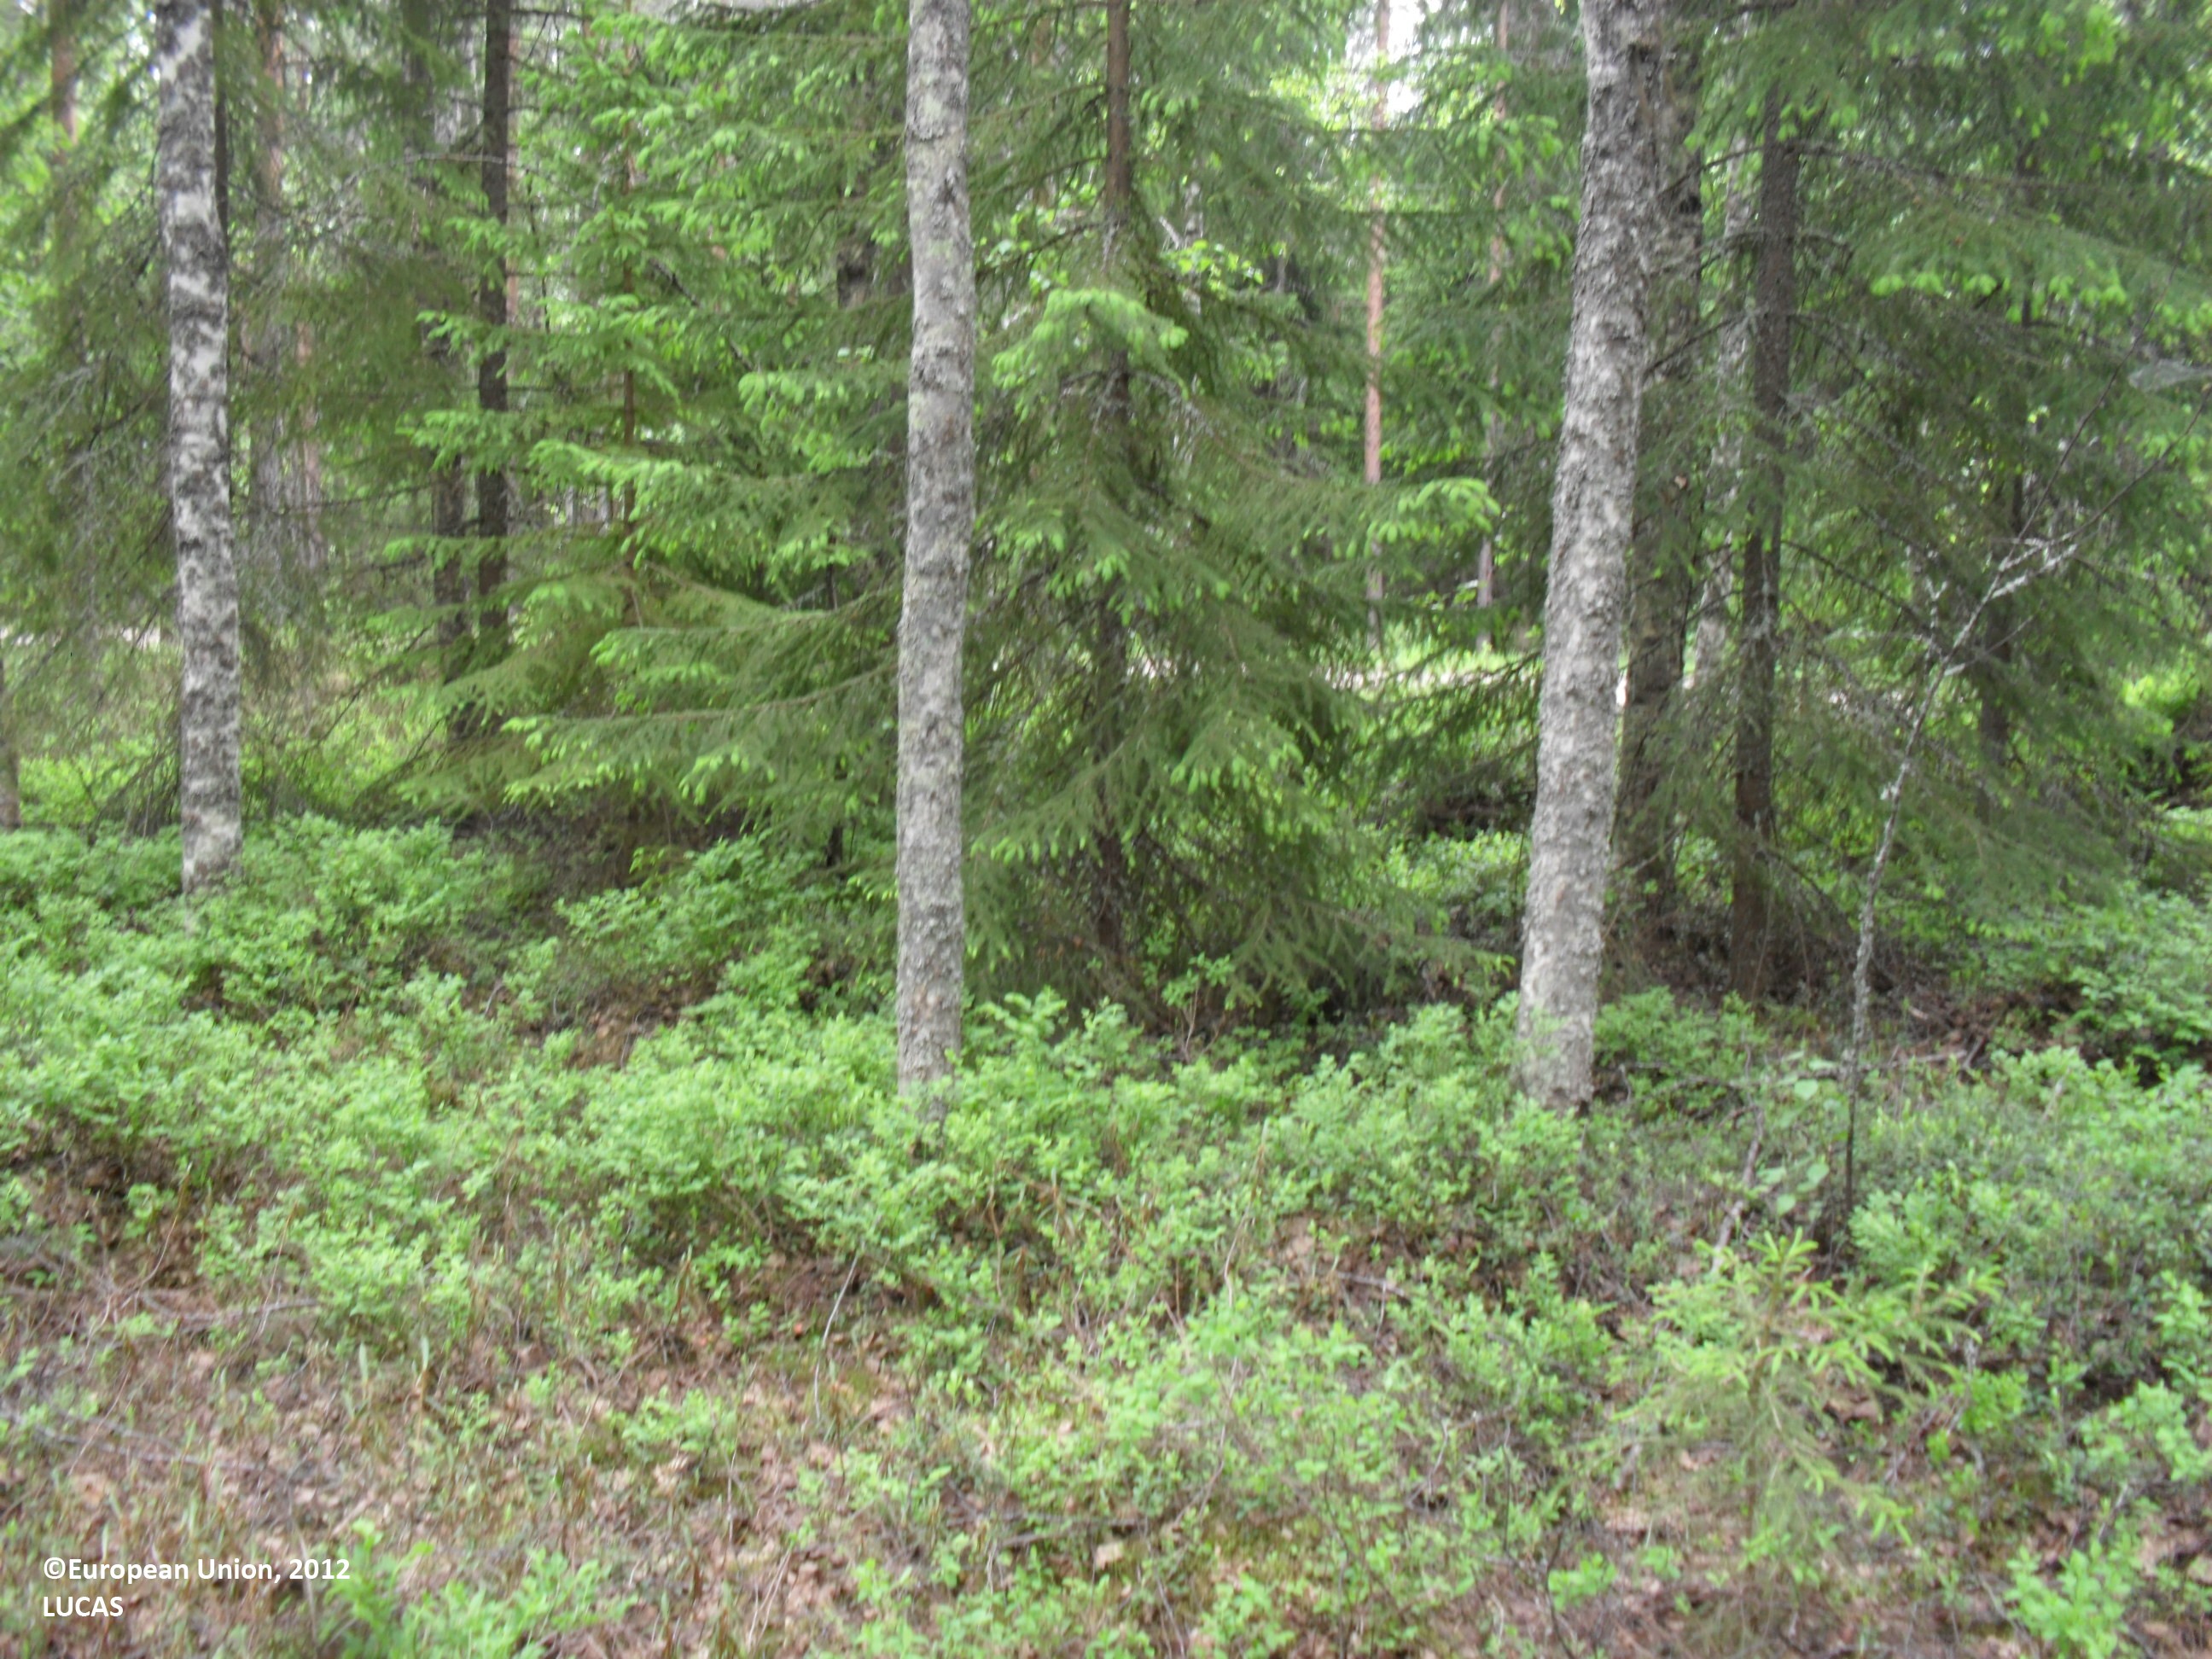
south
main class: Woodland
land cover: Other mixed woodland
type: boreal forest
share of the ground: 50 - 75 %
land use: Forestry
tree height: > 5 m
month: June
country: FI
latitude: 63.2412
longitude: 23.5833
